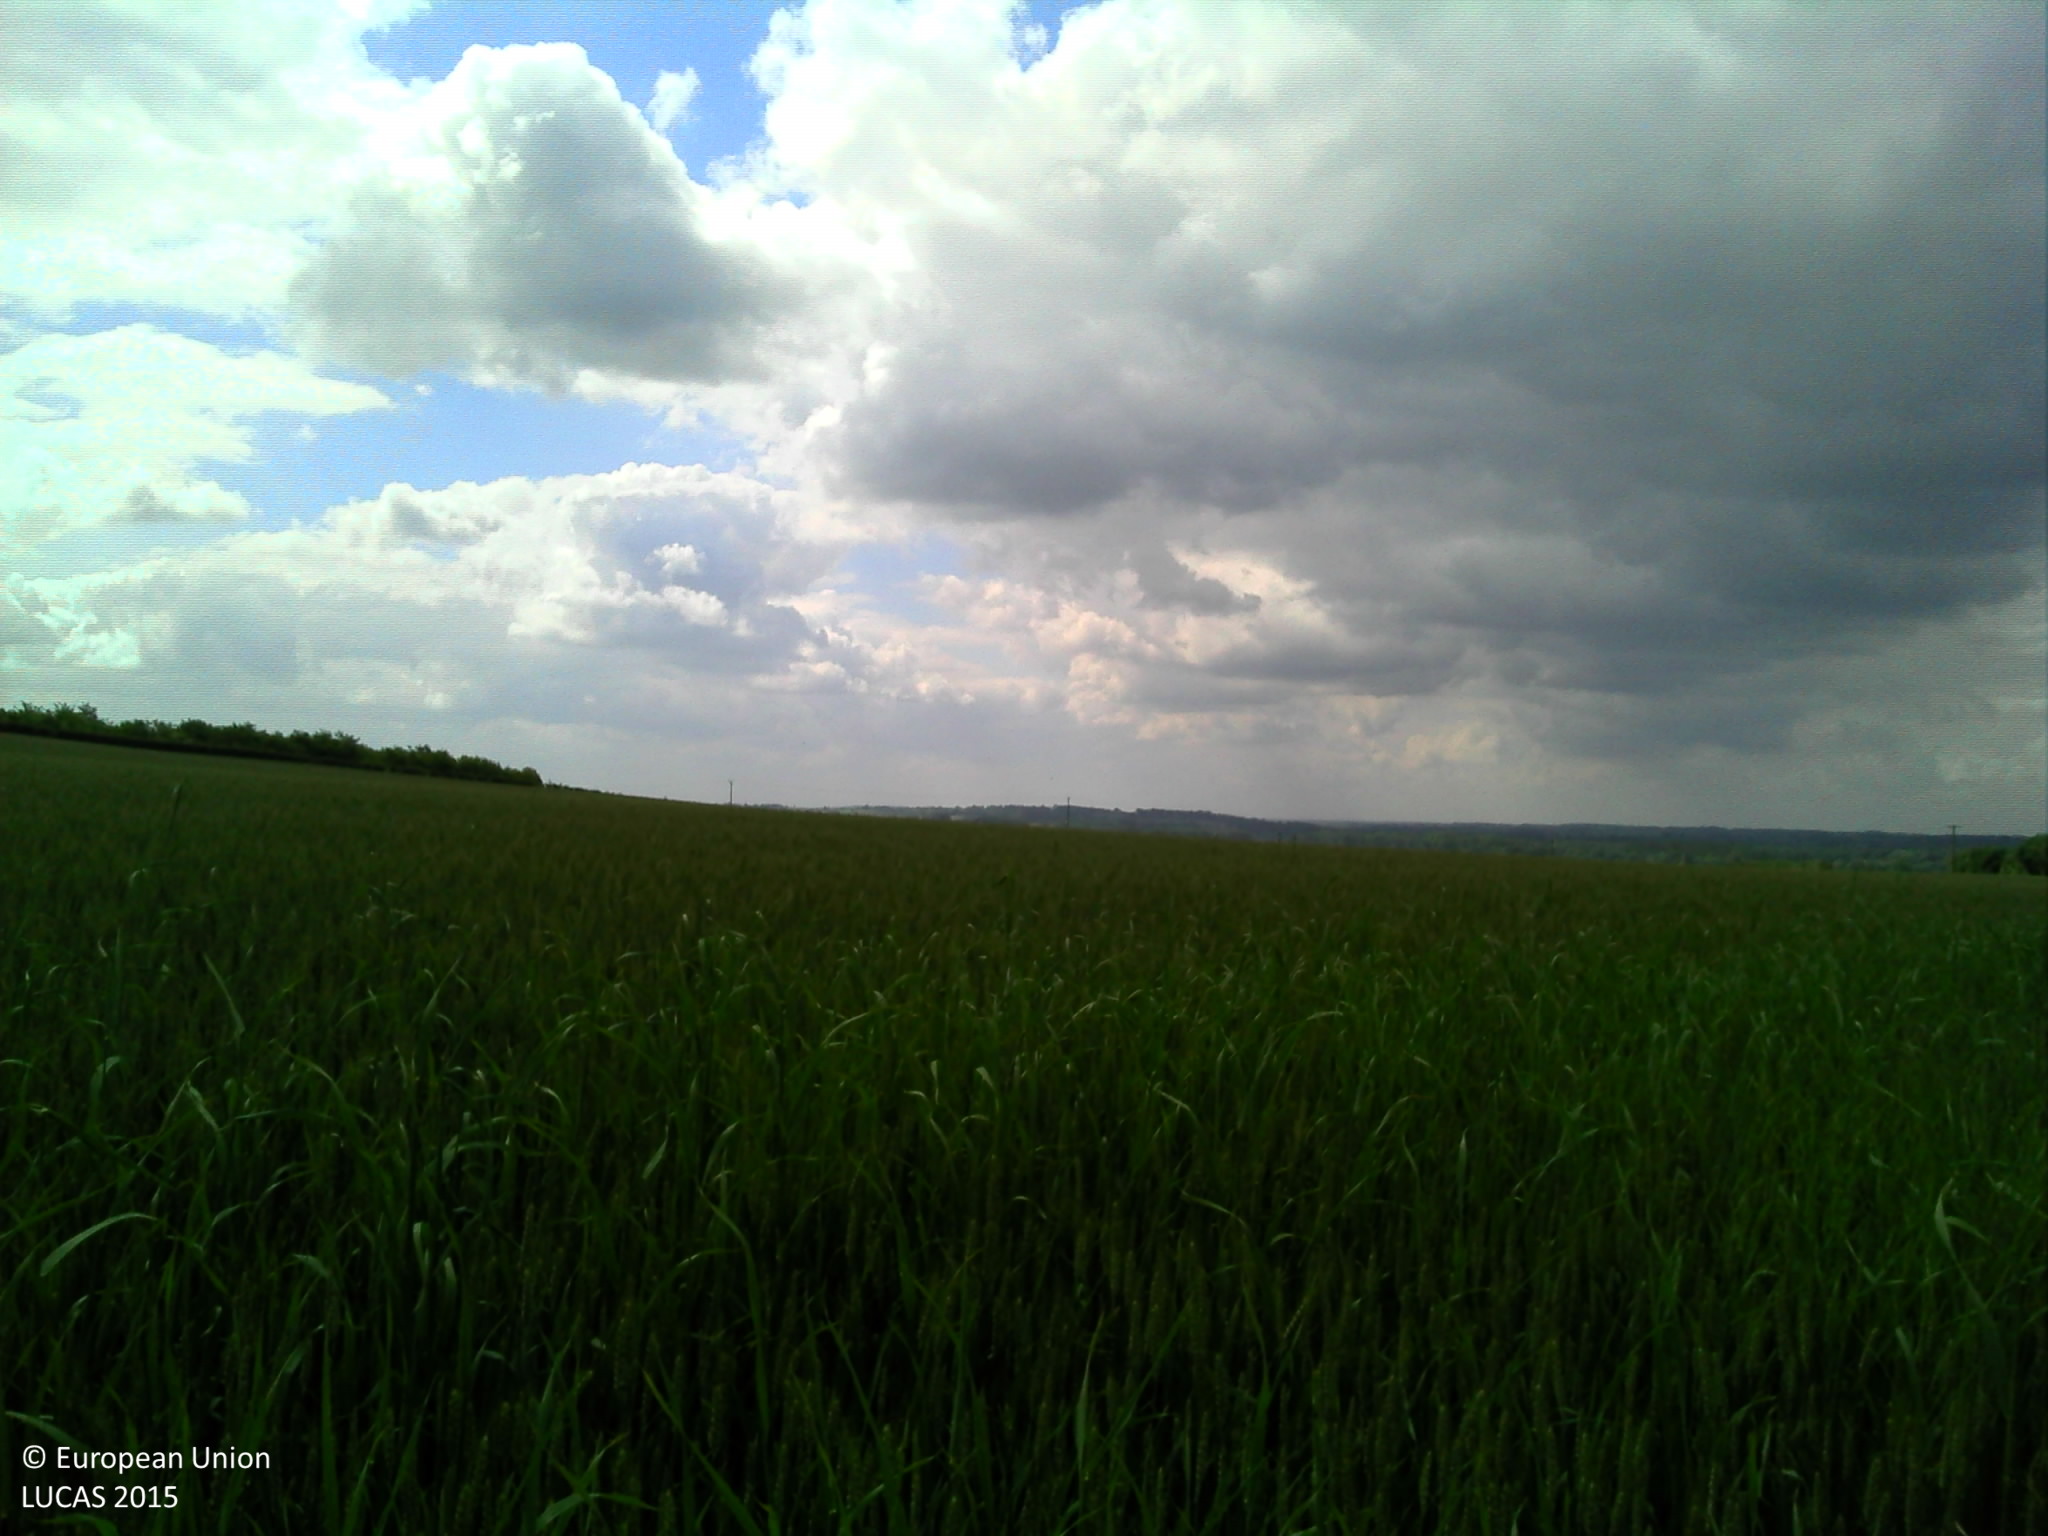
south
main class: Cropland
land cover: Common wheat
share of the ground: > 75 %
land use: Agriculture (excluding fallow land and kitchen gardens)
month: May
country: FR
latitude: 48.0532
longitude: -0.0507
